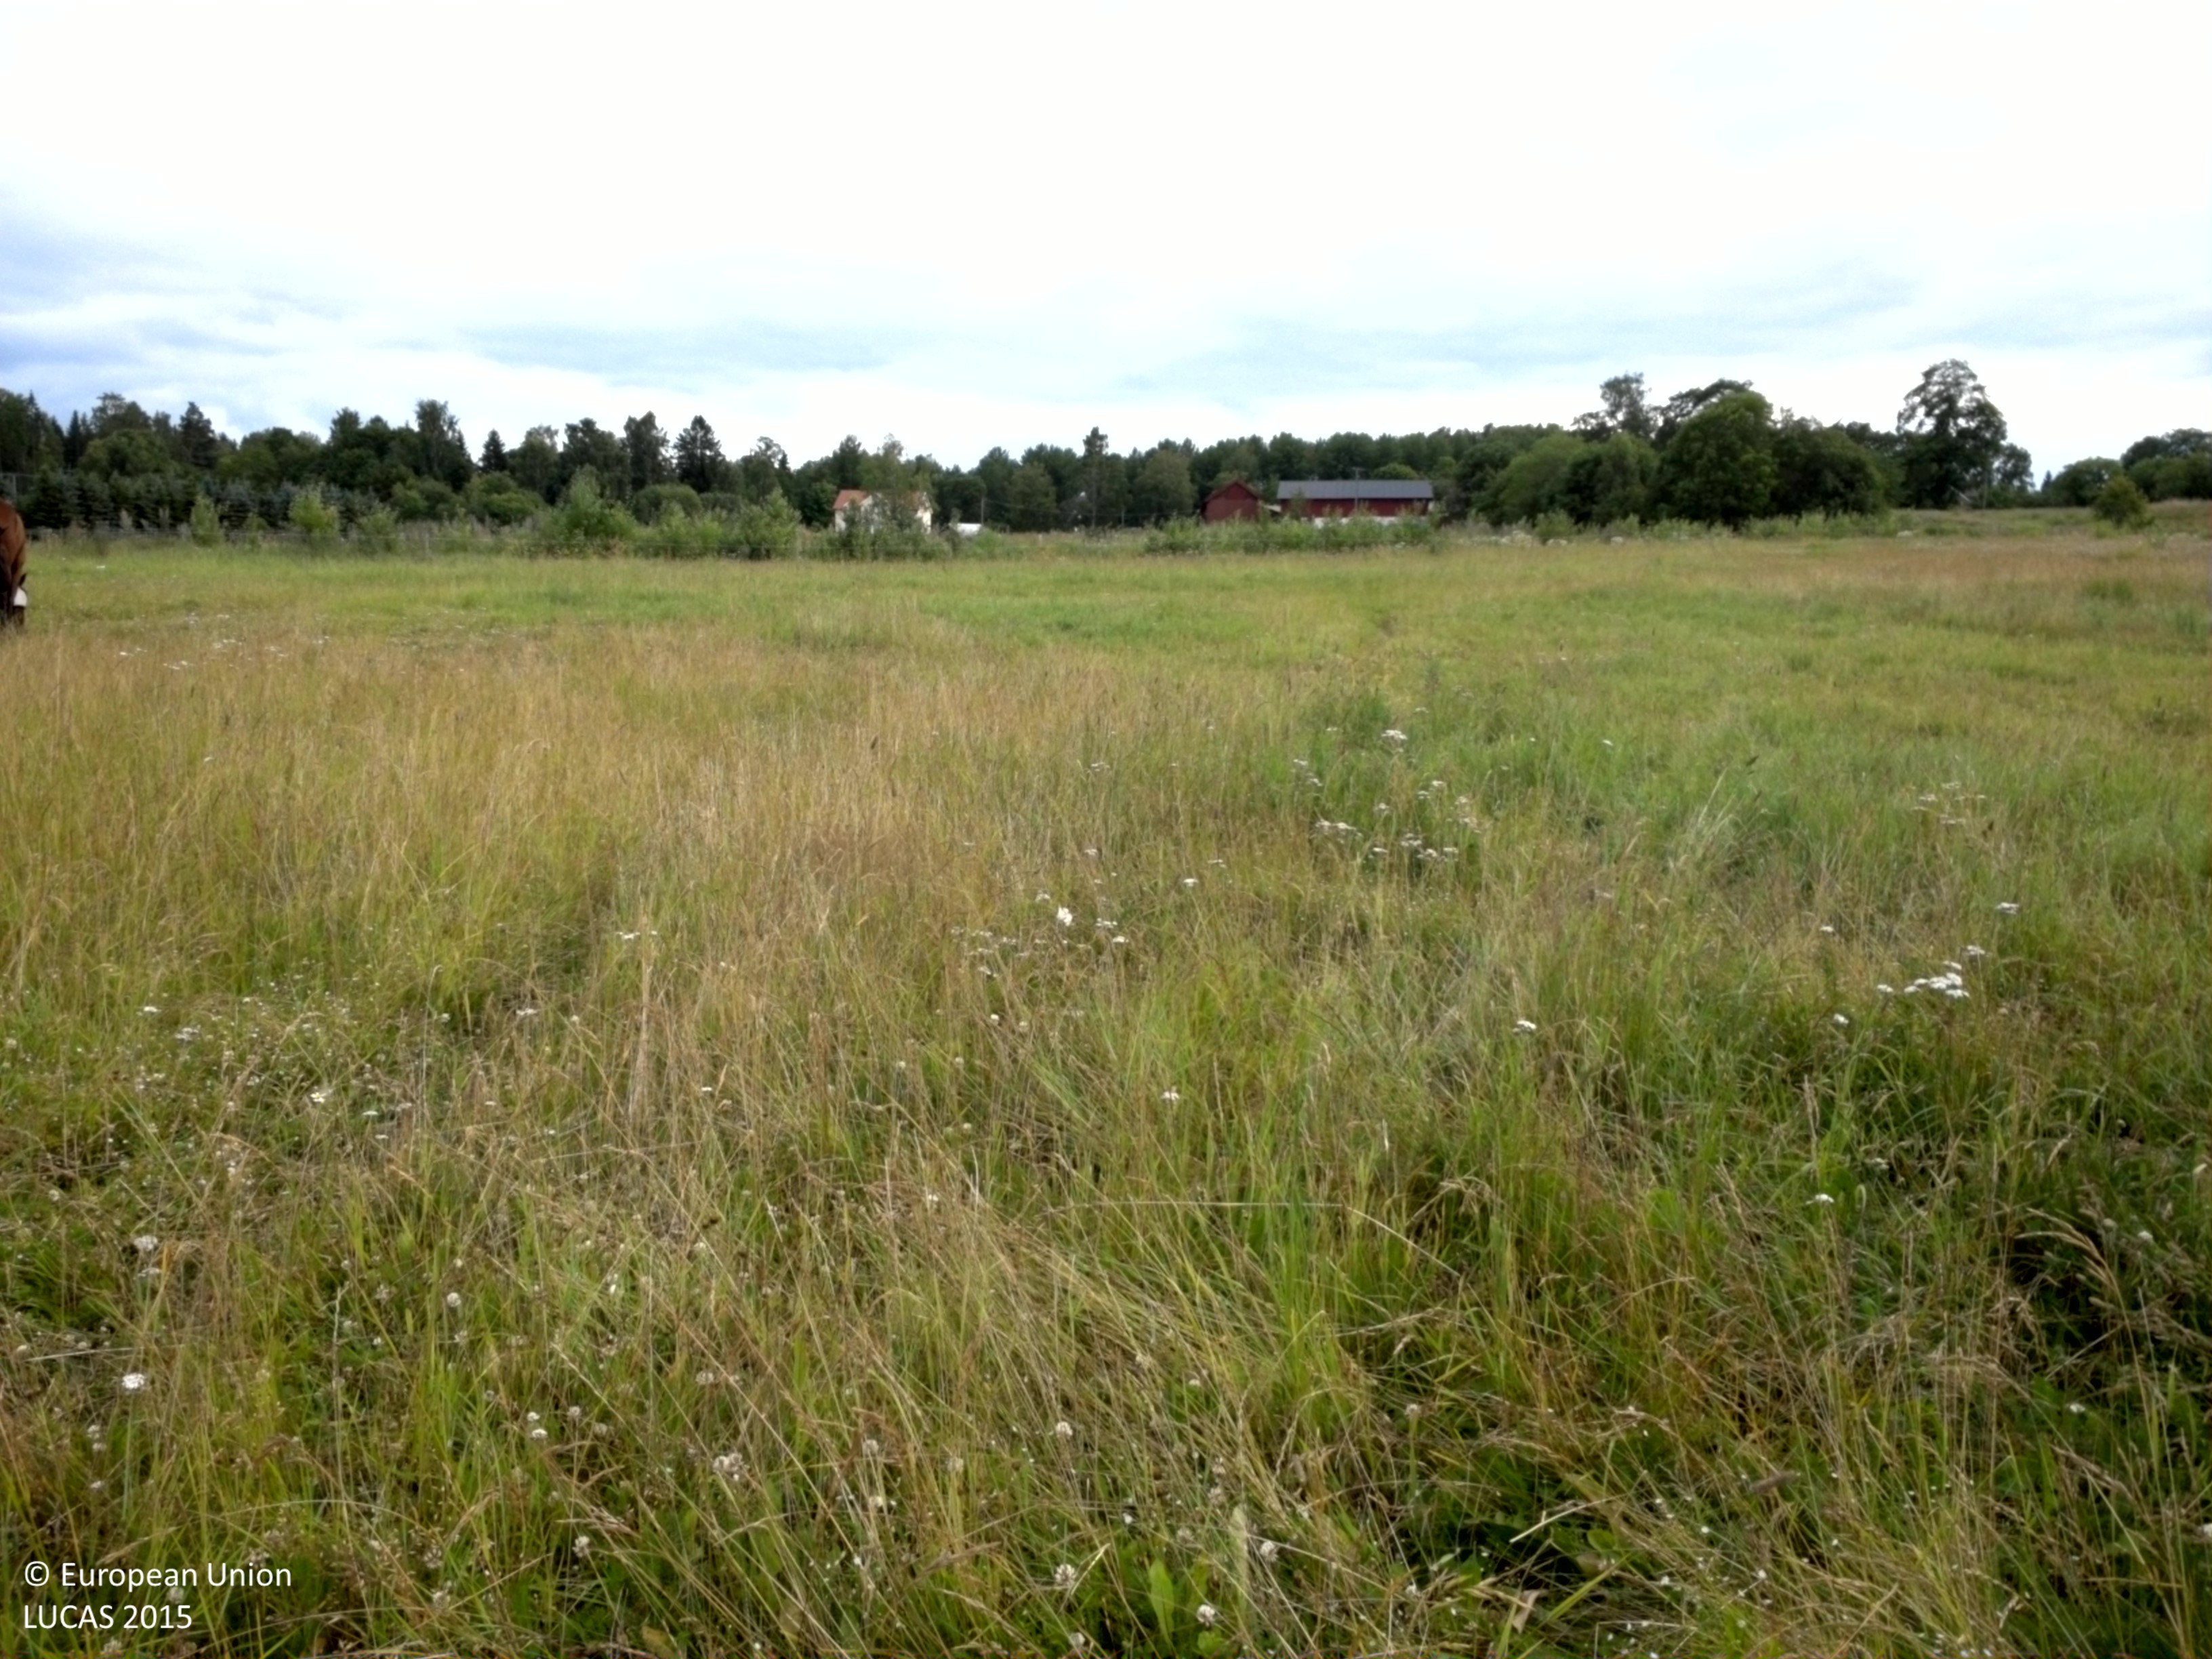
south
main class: Grassland
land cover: Grassland without tree/shrub cover
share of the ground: > 75 %
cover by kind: herbaceous plants 100 %
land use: Agriculture (excluding fallow land and kitchen gardens)
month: July
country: SE
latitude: 59.8398
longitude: 18.6895
